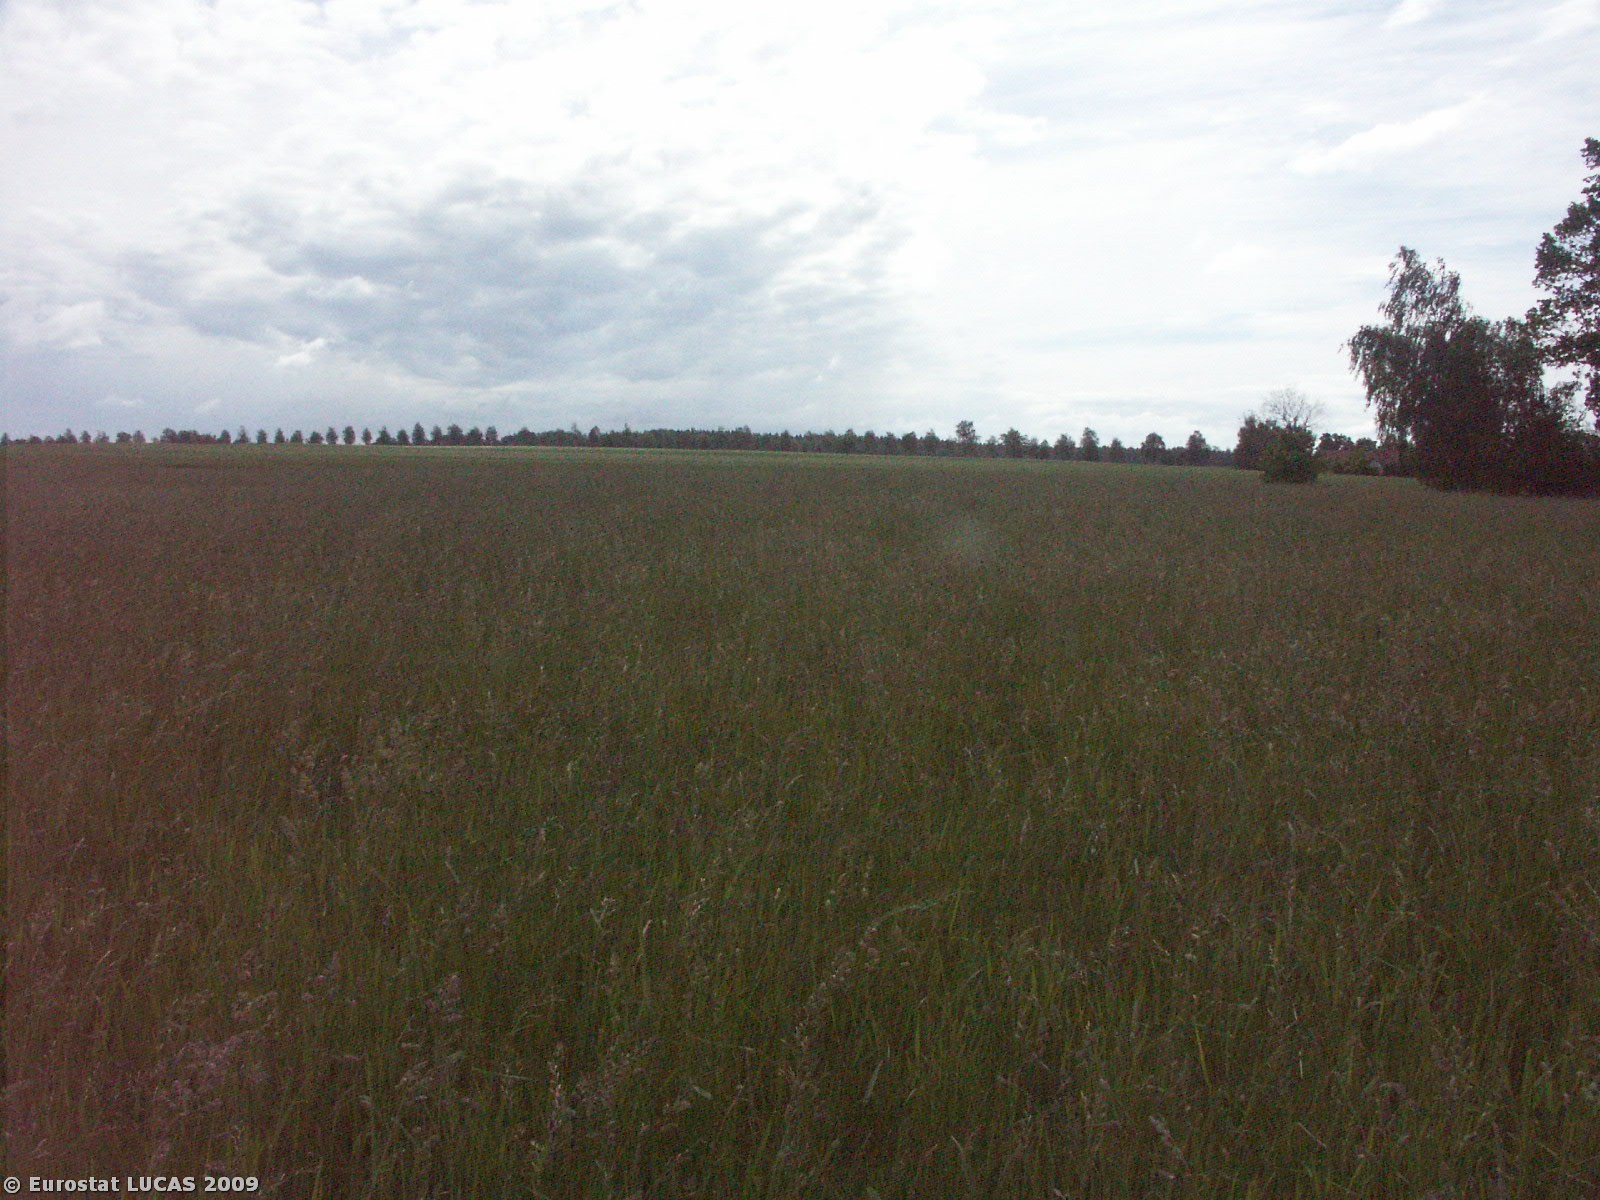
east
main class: Grassland
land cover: Grassland without tree/shrub cover
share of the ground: > 75 %
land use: Agriculture (excluding fallow land and kitchen gardens)
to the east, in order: Grassland without tree/shrub cover; Tracks; Rape and turnip rape; Clovers; Common wheat
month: May
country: CZ
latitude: 48.9350
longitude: 14.6837
